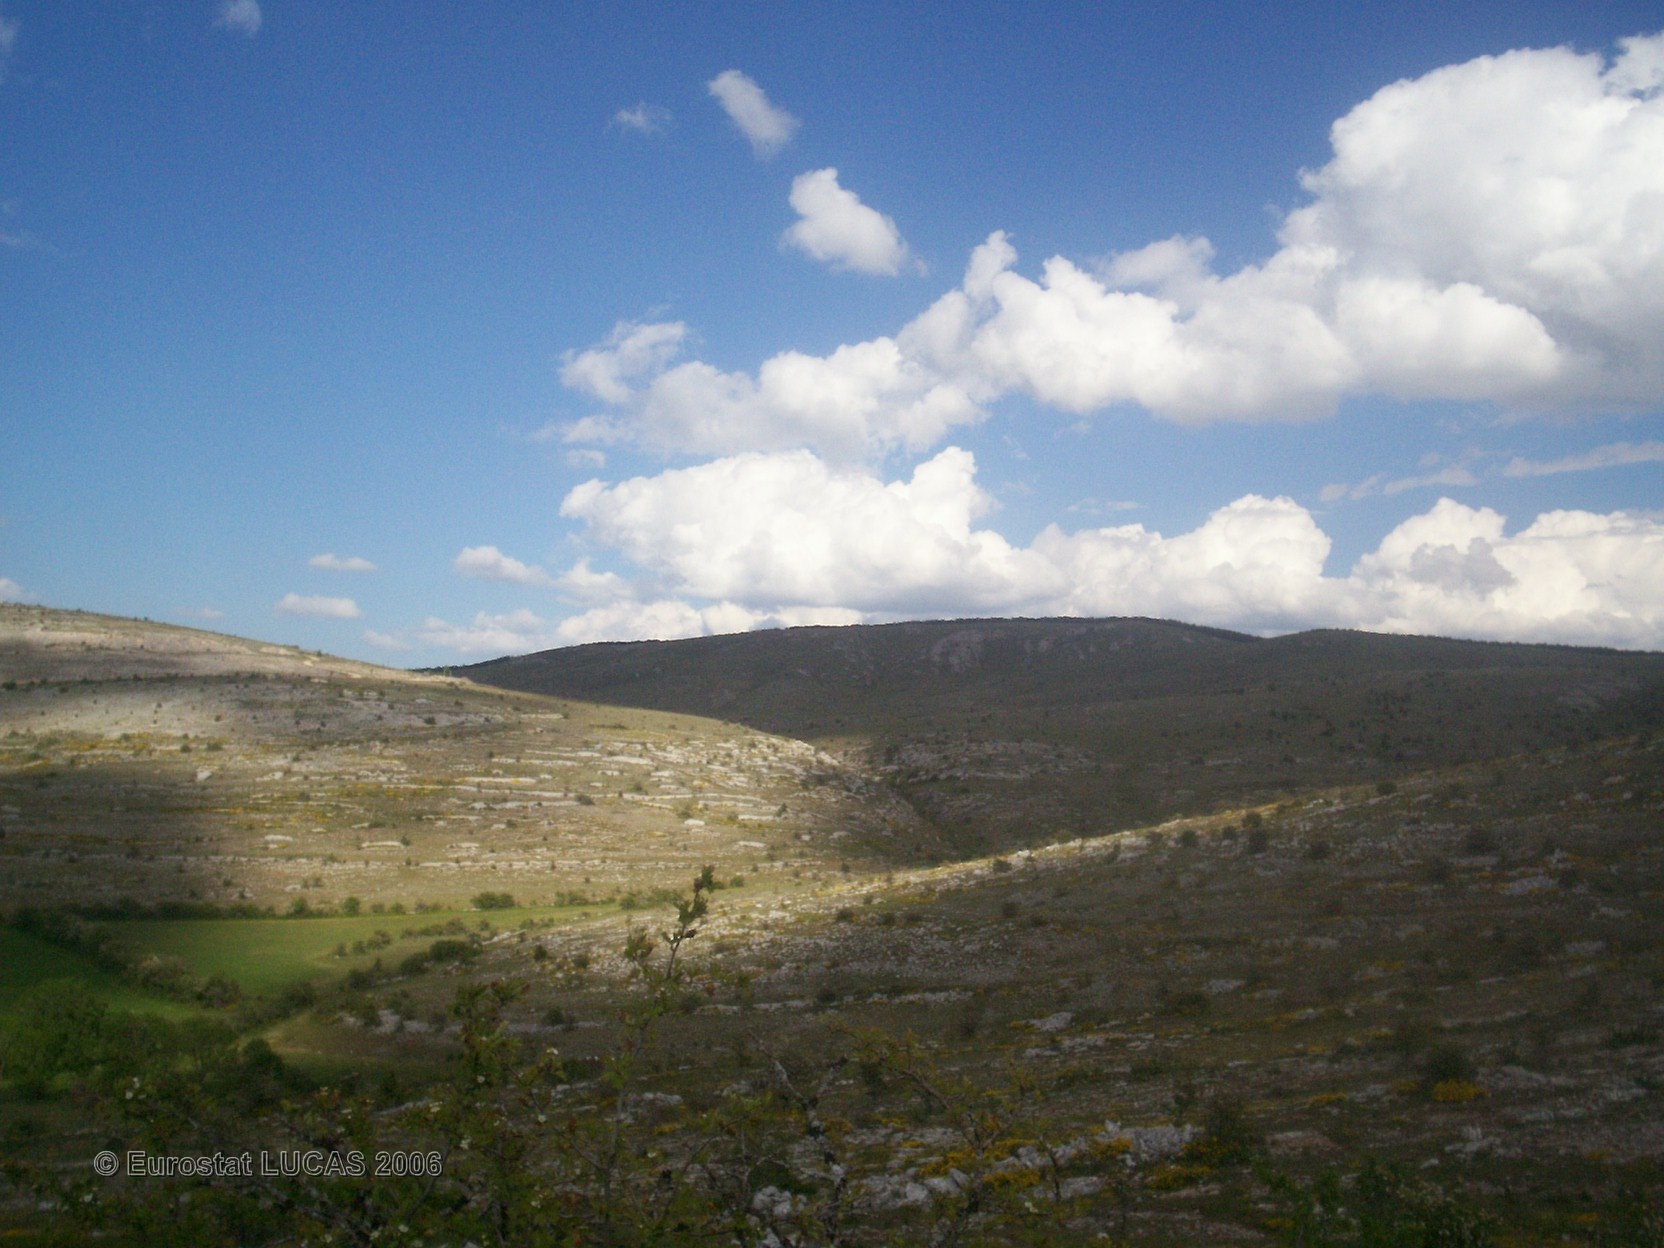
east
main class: Grassland
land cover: Grassland without tree/shrub cover
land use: Agriculture (excluding fallow land and kitchen gardens)
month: June
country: FR
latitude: 44.2525
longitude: 3.4560
